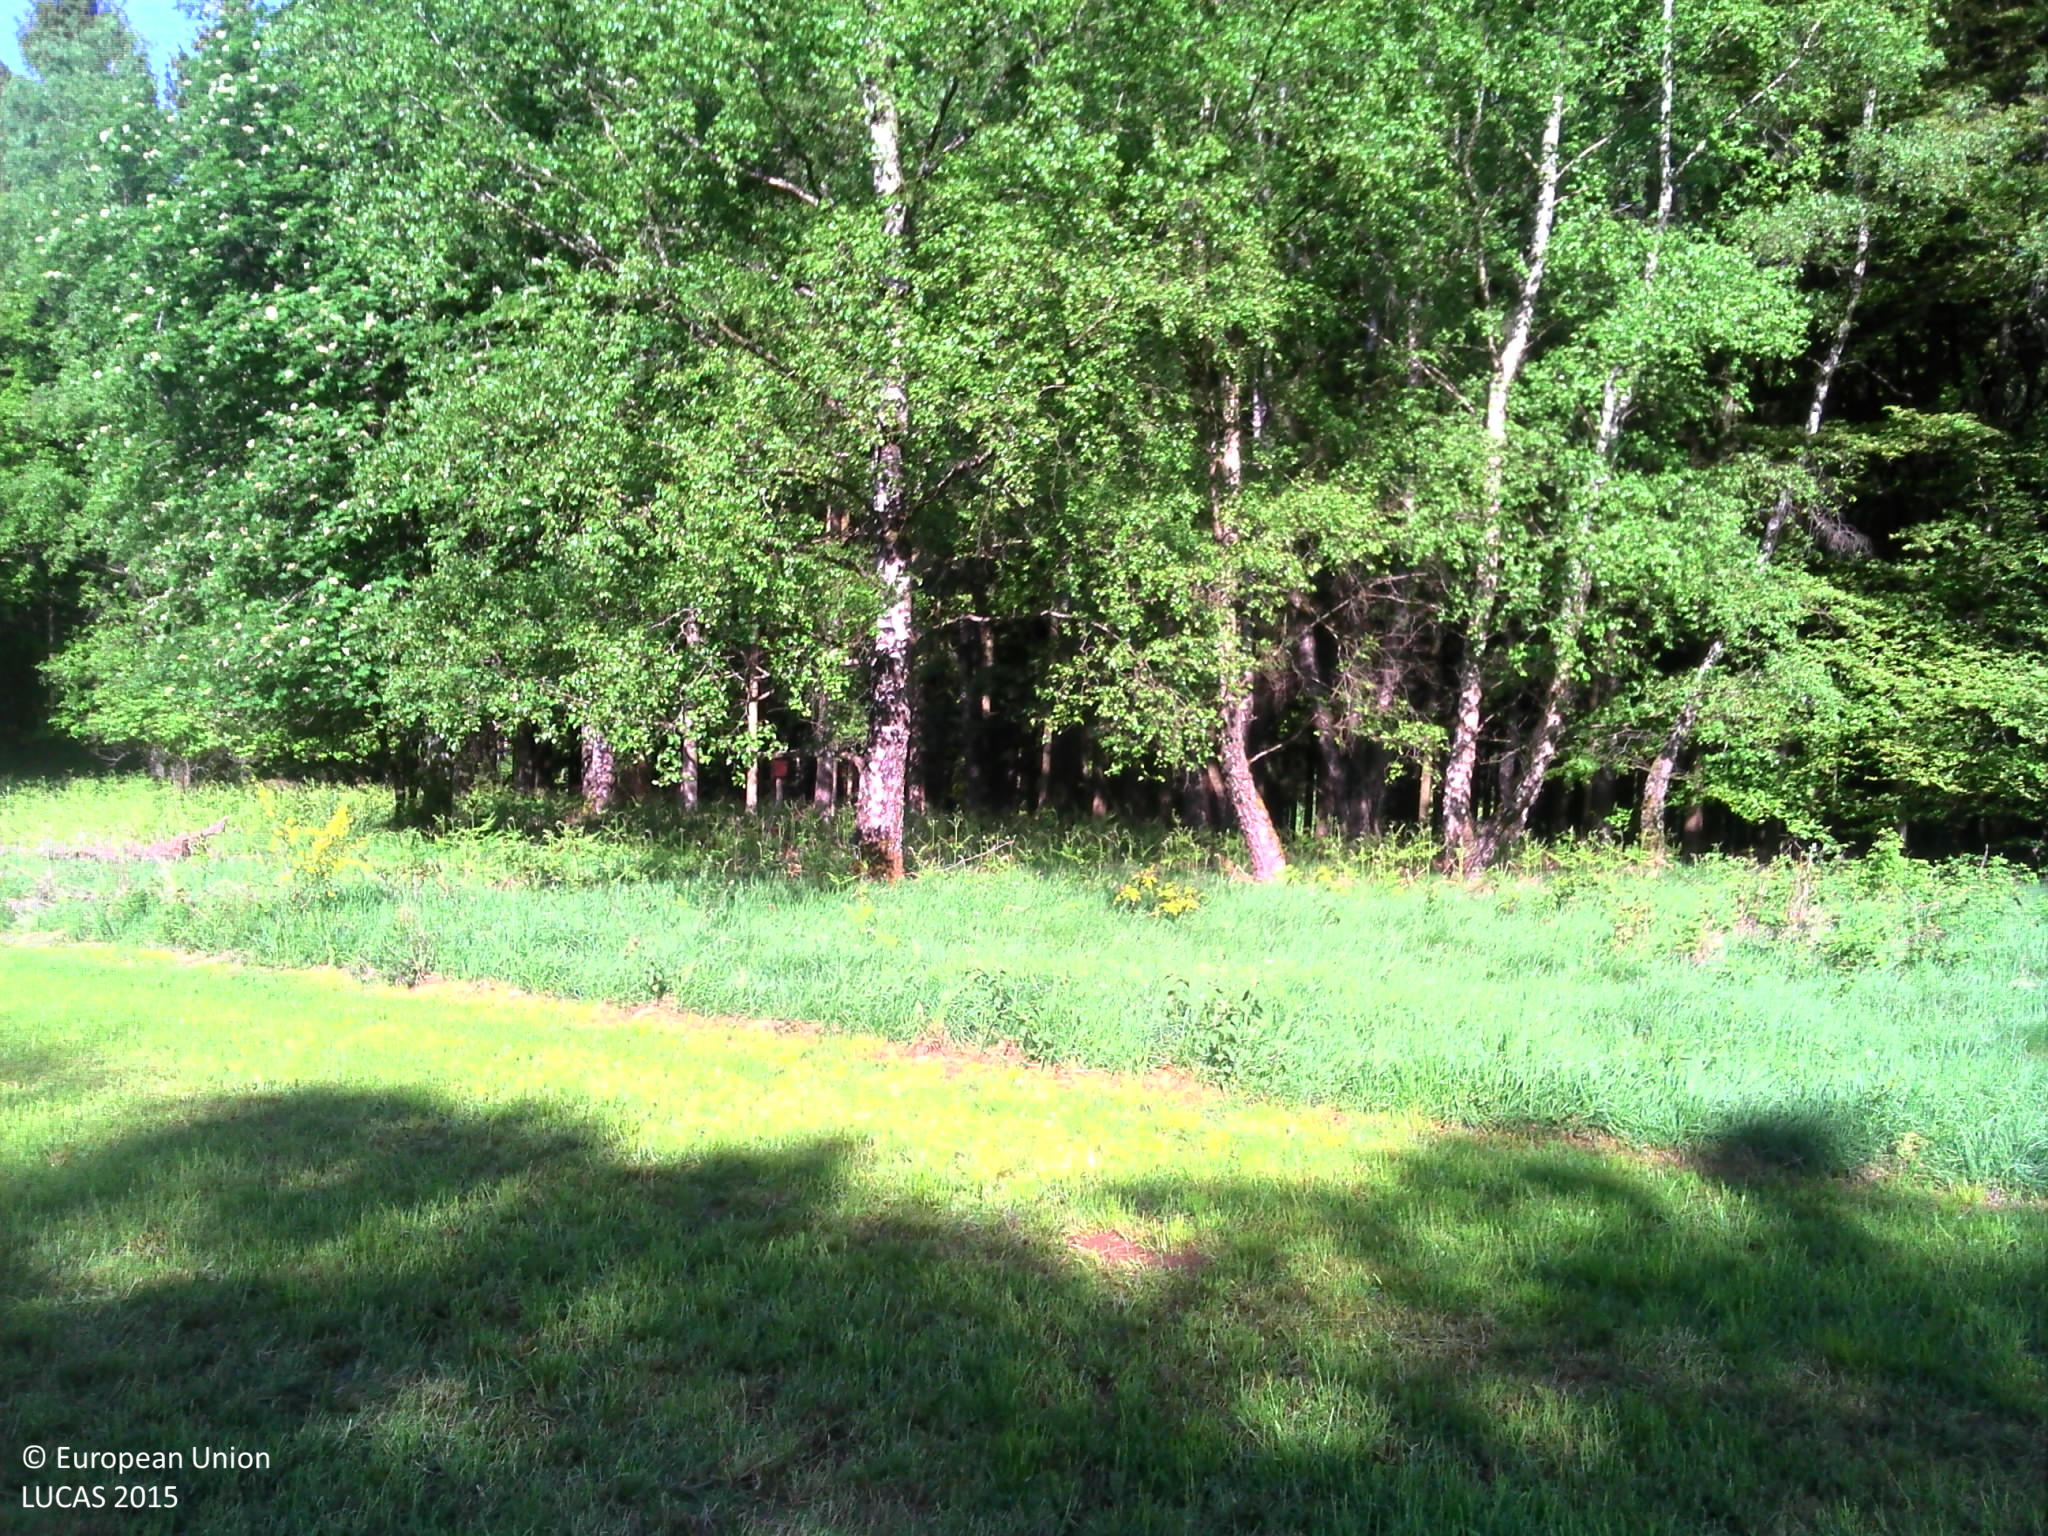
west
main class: Grassland
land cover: Grassland without tree/shrub cover
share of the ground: > 75 %
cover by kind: herbaceous plants 100 %
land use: Agriculture (excluding fallow land and kitchen gardens)
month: May
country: LU
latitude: 49.8373
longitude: 5.8138
